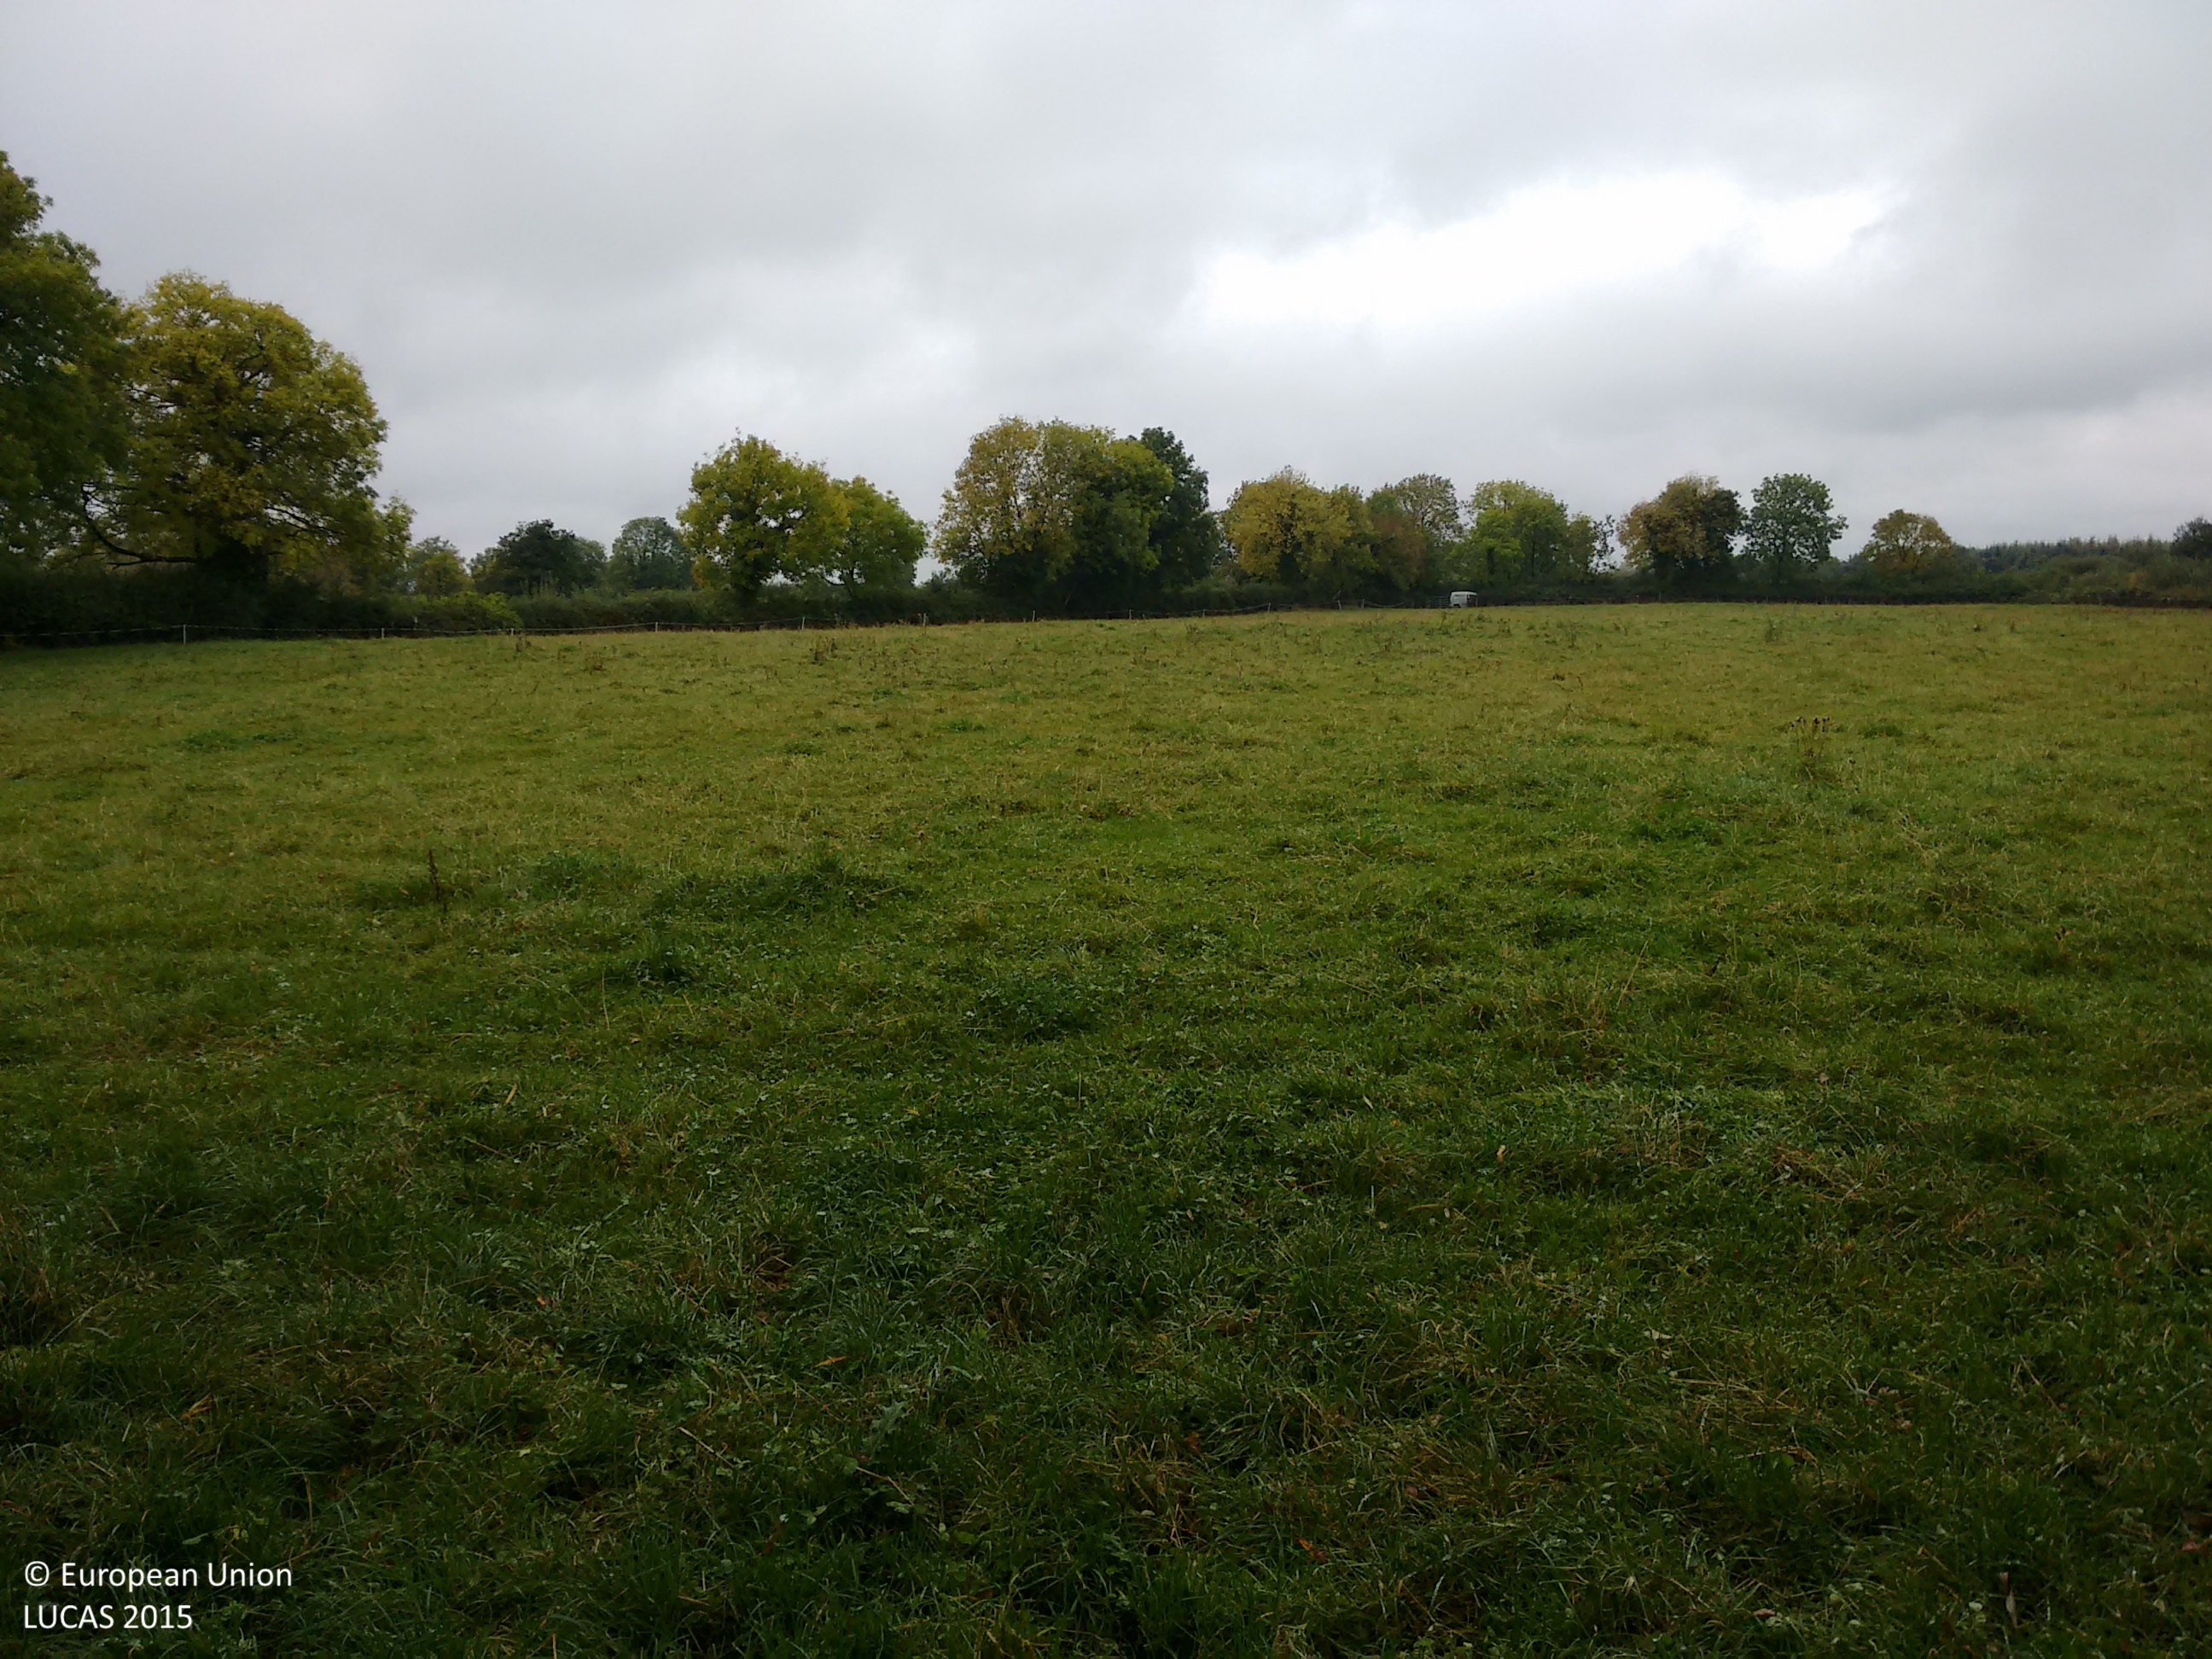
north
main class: Grassland
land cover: Grassland without tree/shrub cover
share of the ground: > 75 %
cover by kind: herbaceous plants 100 %
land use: Agriculture (excluding fallow land and kitchen gardens)
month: October
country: IE
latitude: 53.6799
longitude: -7.9940
